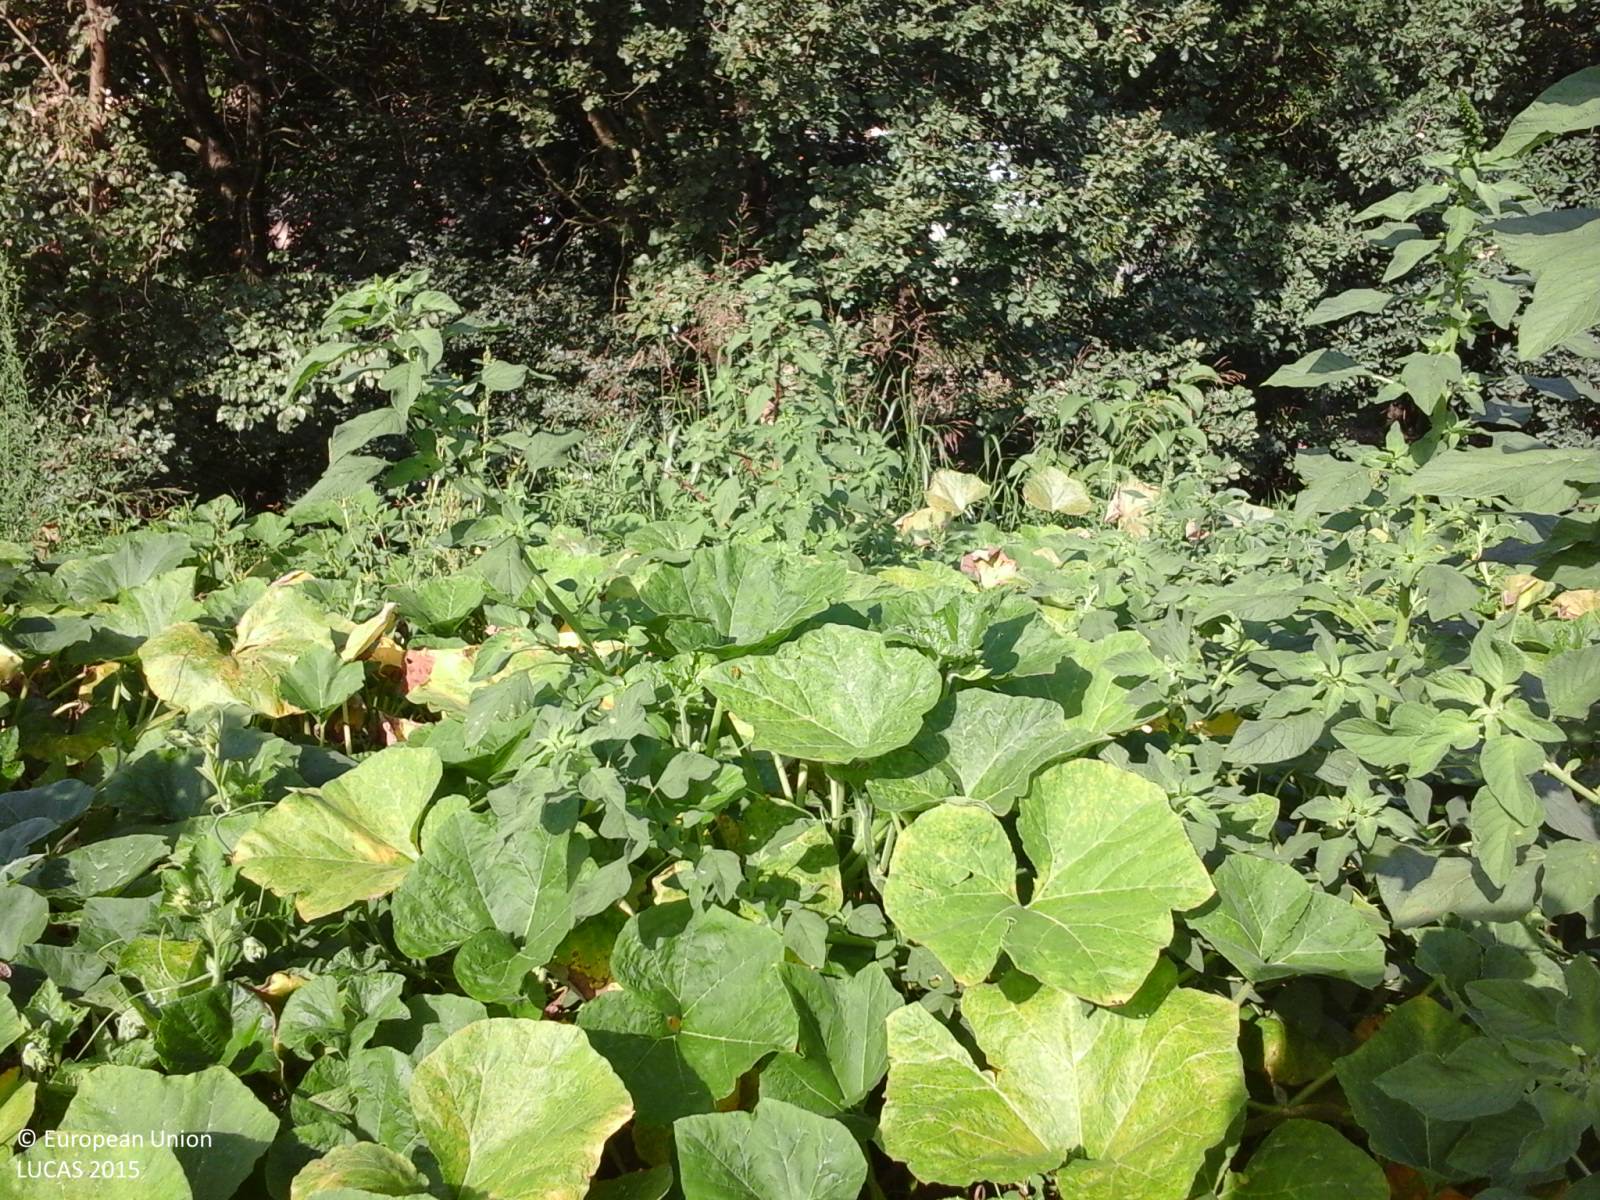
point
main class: Cropland
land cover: Other fresh vegetables
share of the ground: > 75 %
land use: Kitchen garden
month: August
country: IT
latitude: 41.5017
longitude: 13.1623
